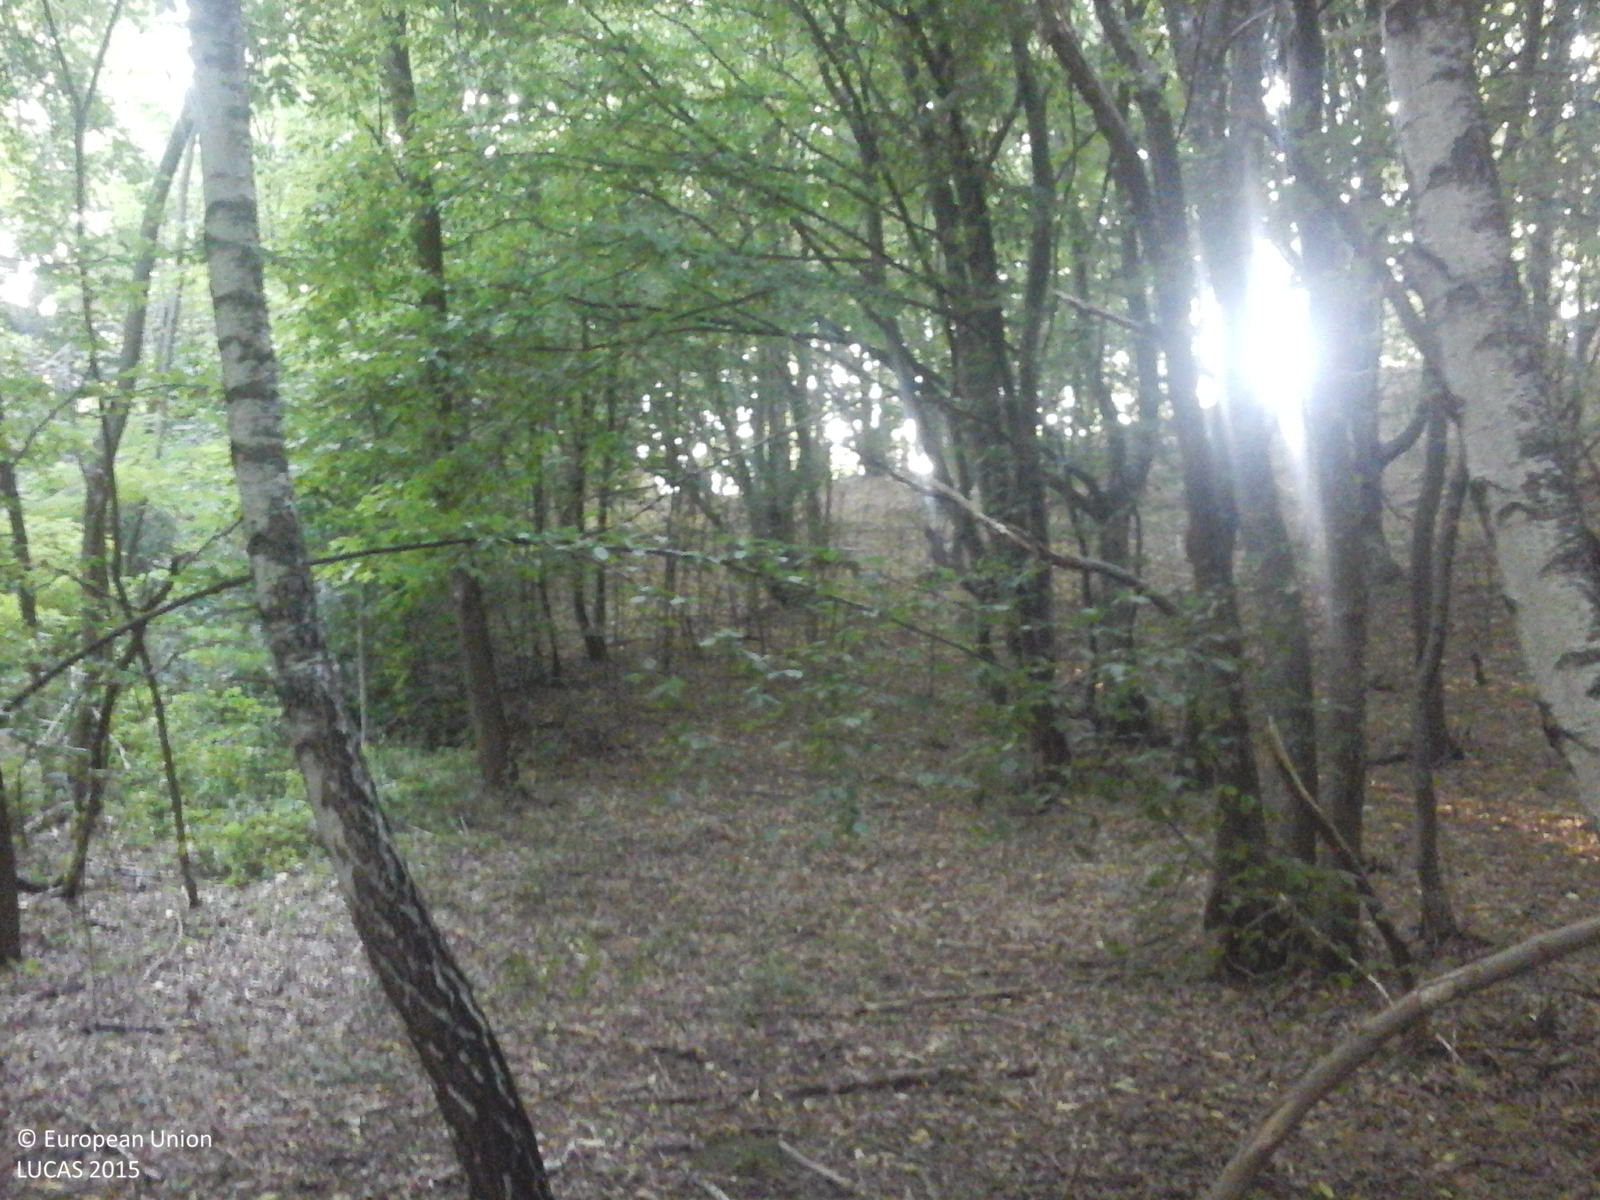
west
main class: Woodland
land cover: Broadleaved woodland
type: beech forest
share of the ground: > 75 %
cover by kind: broadleaved forest trees 100 %
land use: Forestry
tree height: > 5 m
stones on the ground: 10 - 25 %
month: July
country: RO
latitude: 45.0584
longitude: 24.5406
